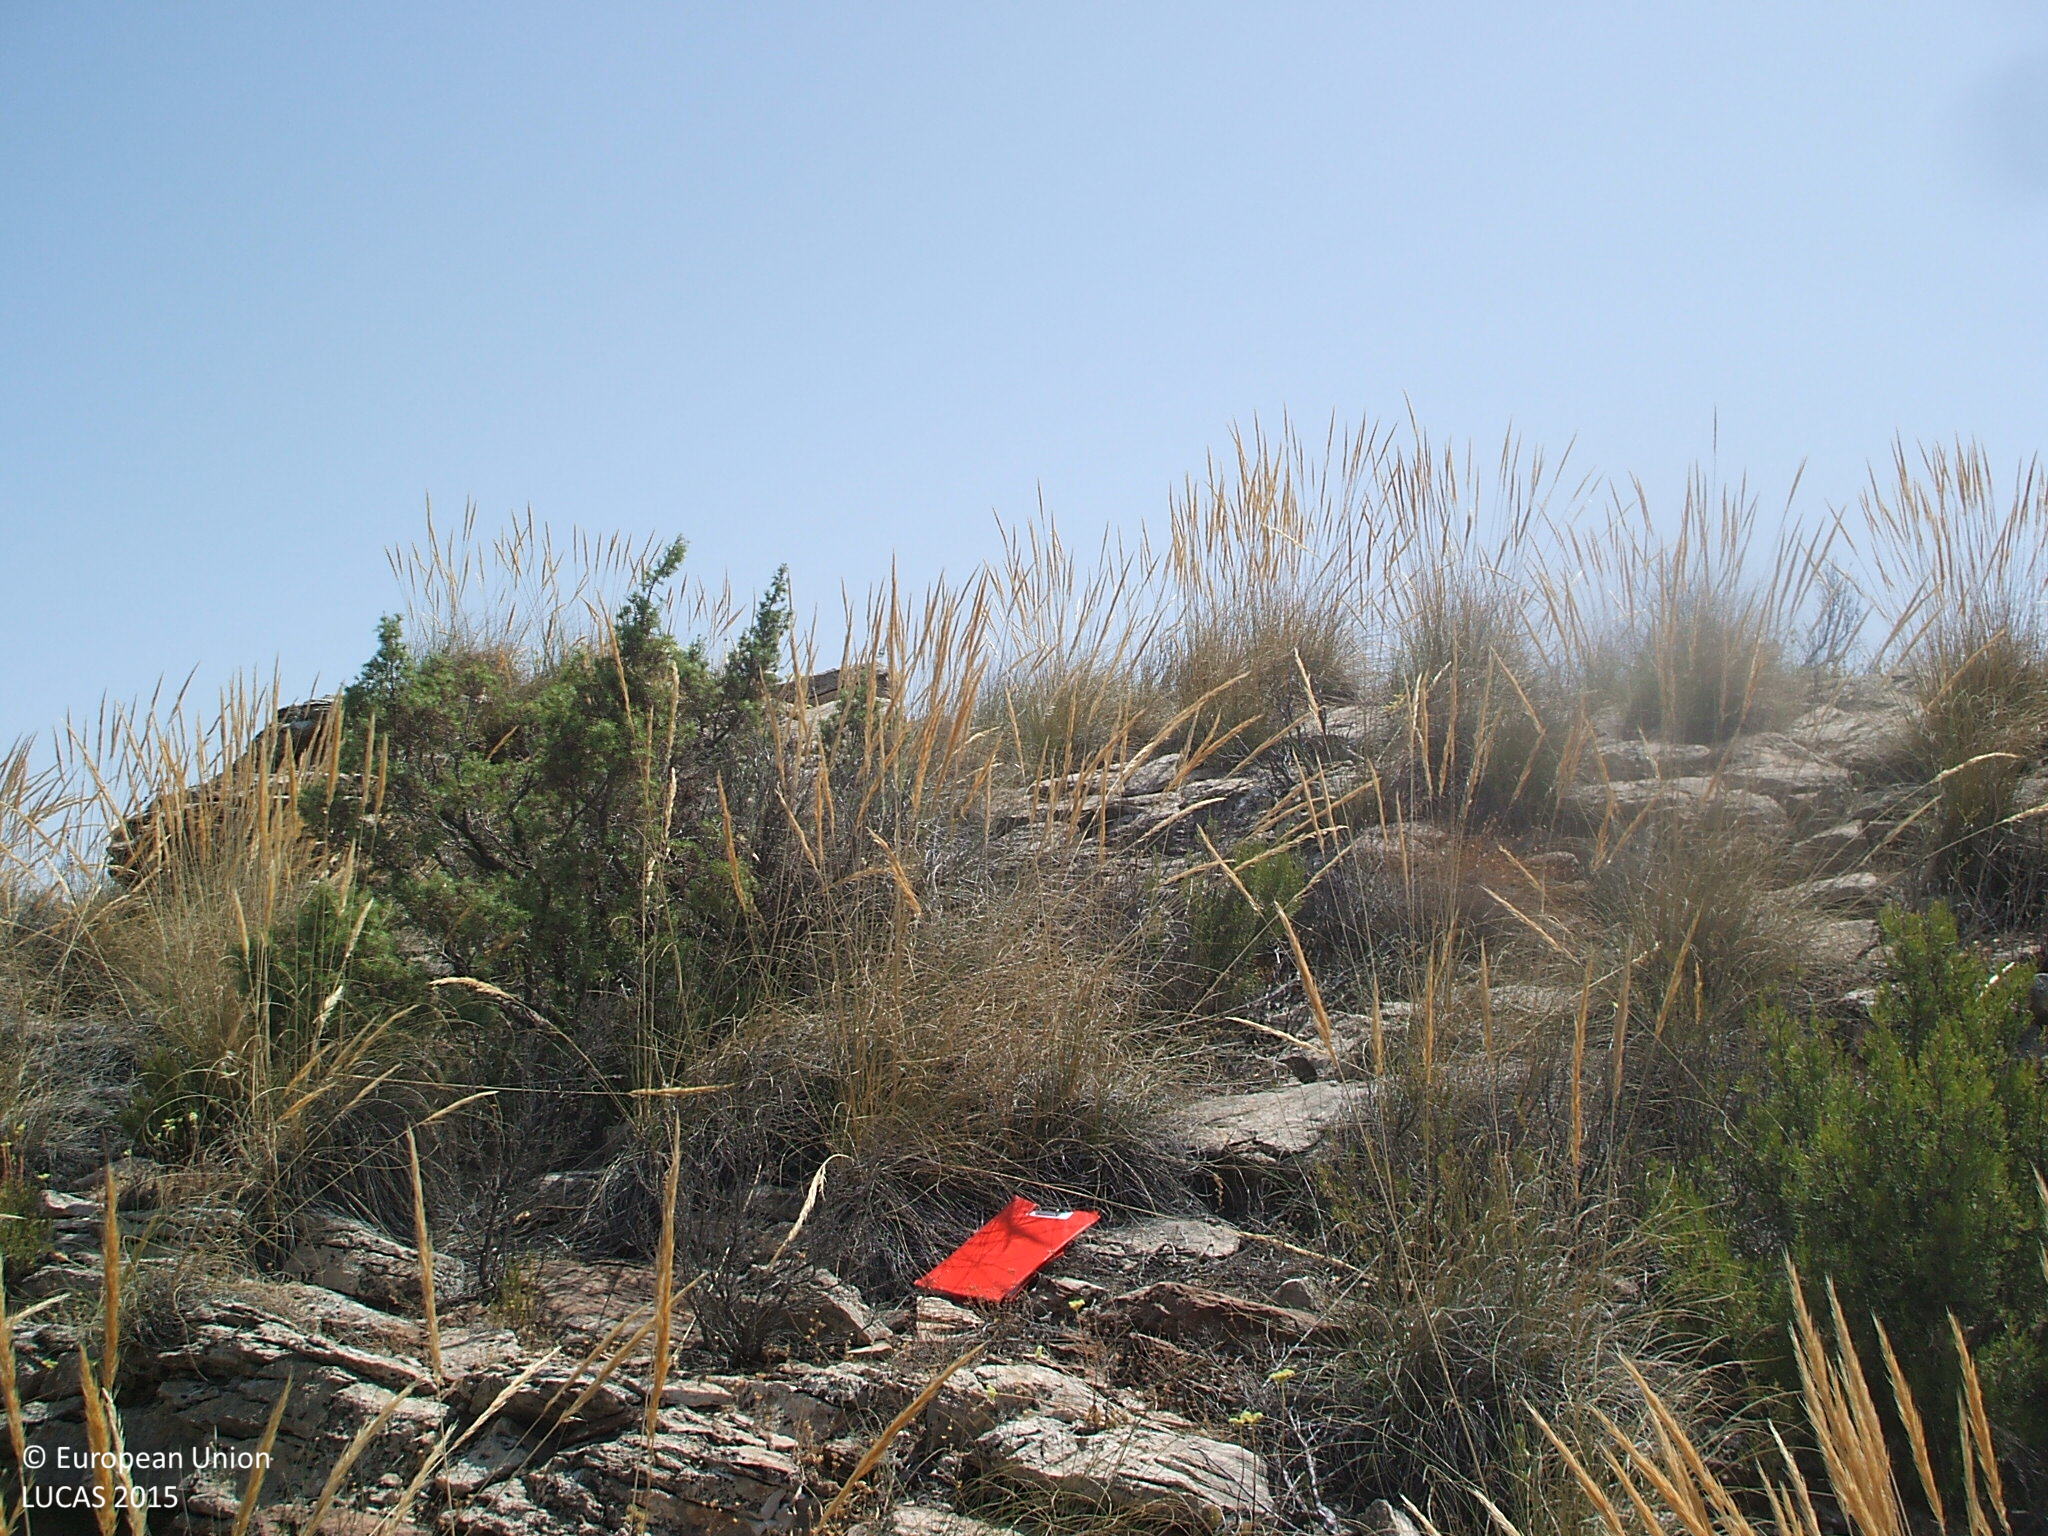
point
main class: Shrubland
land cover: Shrubland without tree cover
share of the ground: 50 - 75 %
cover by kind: shrubs 60 %, herbaceous plants 20 %, lichens and mosses 20 %
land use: Semi-natural and natural areas not in use
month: July
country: ES
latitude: 37.3105
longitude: -2.3136
